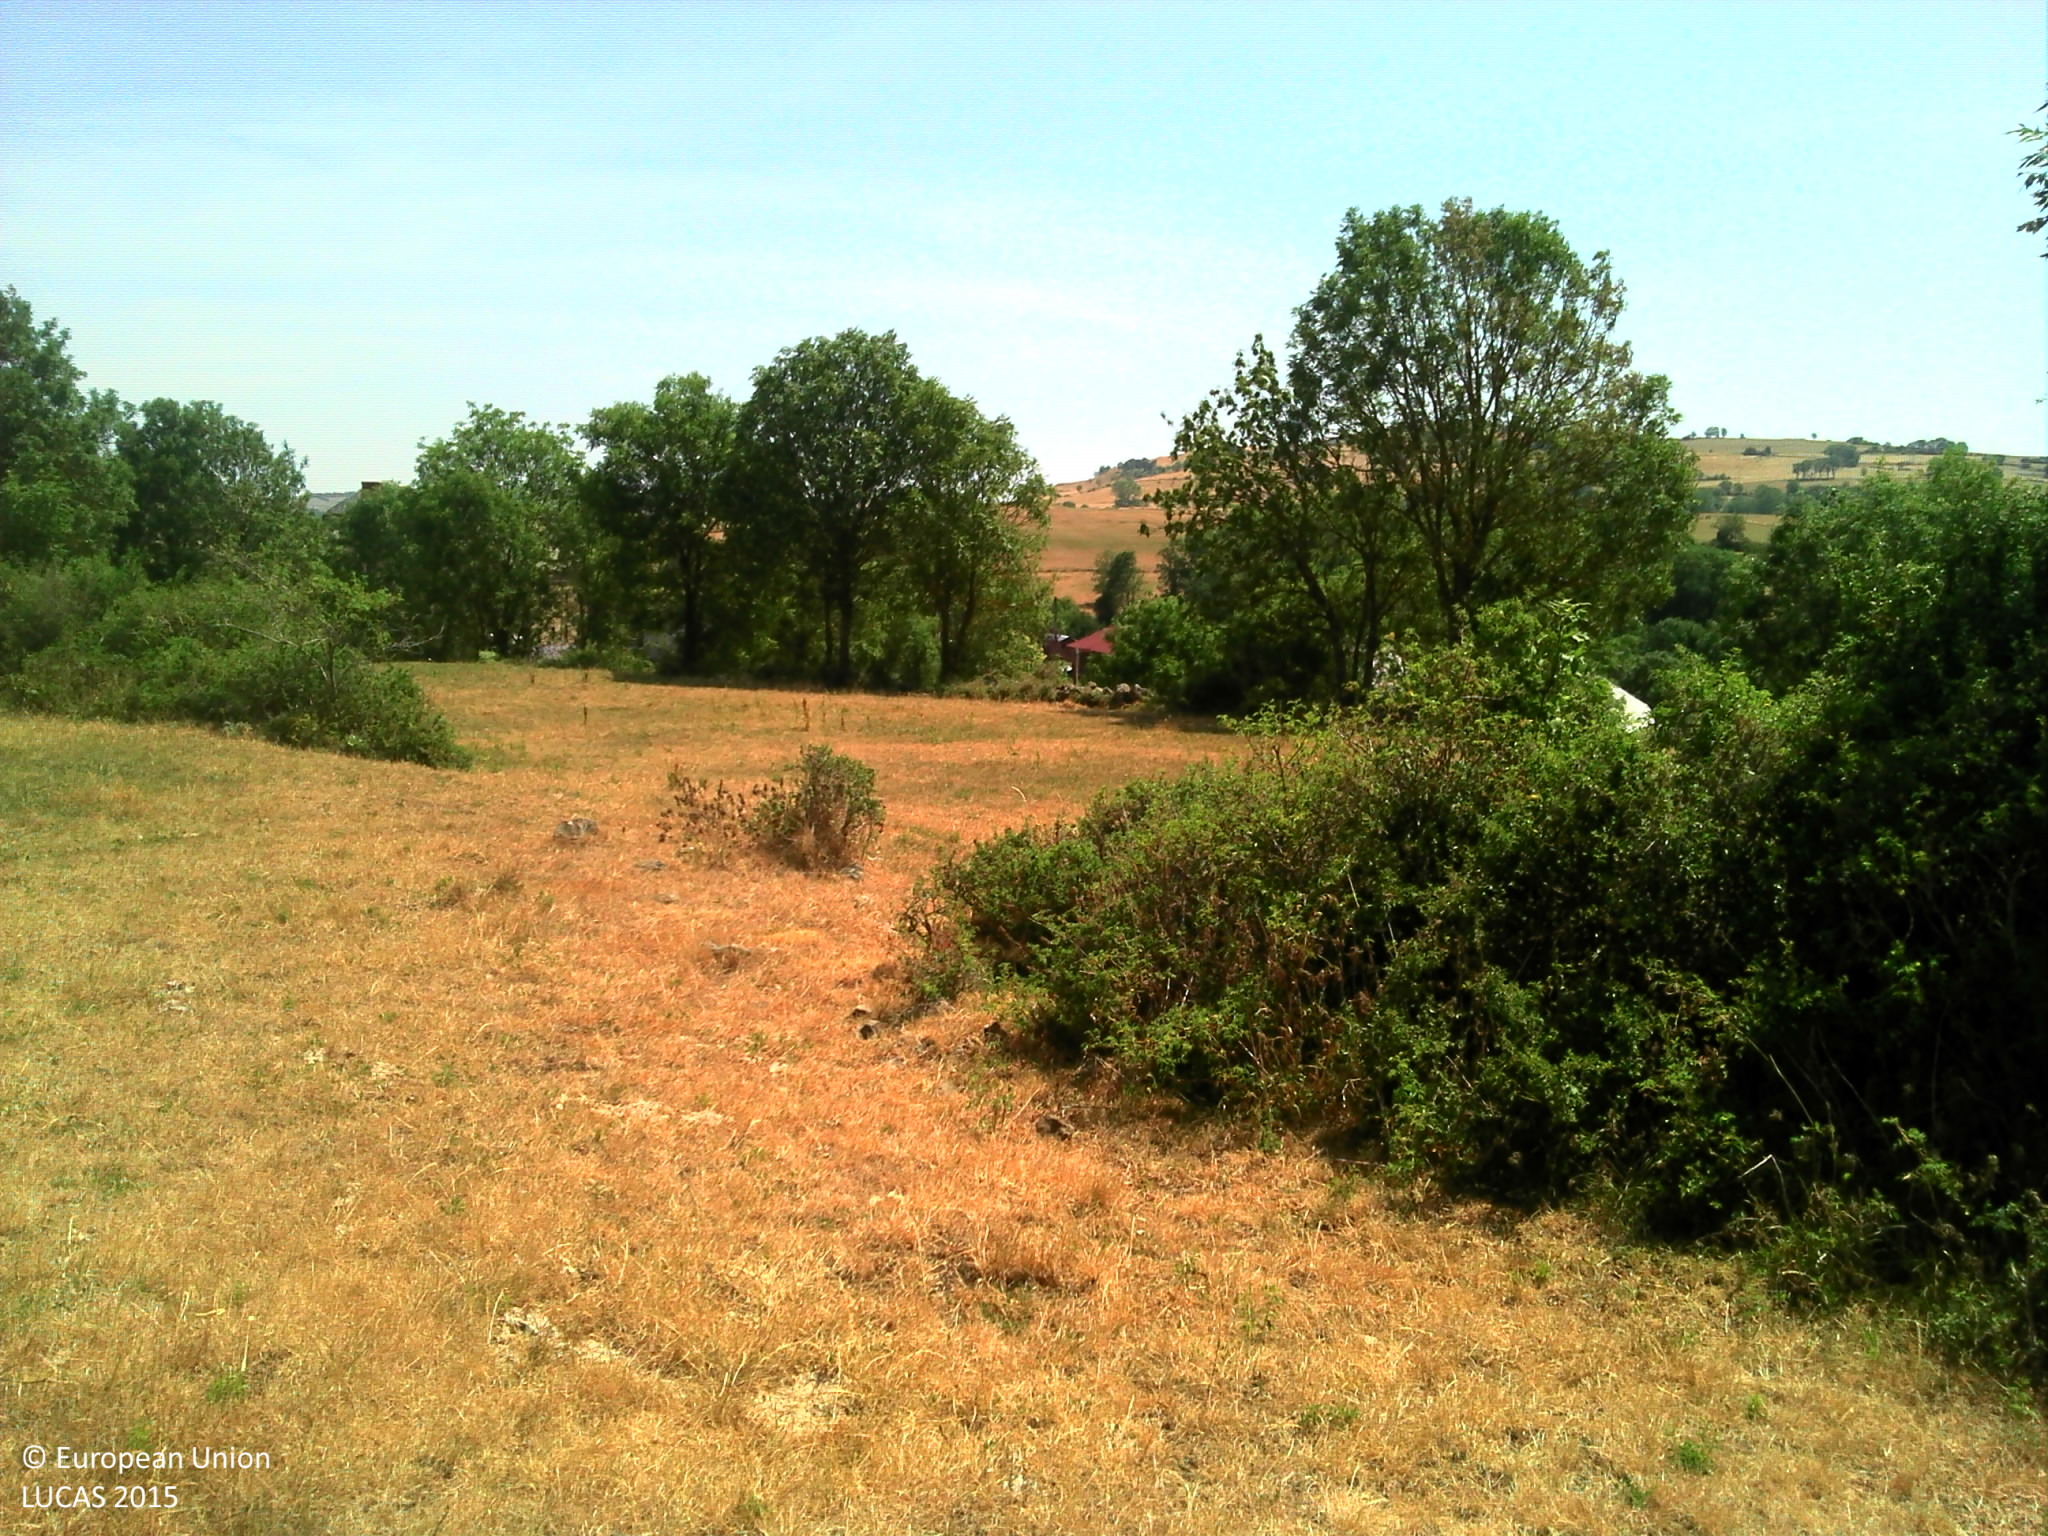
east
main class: Grassland
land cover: Grassland without tree/shrub cover
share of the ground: > 75 %
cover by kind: herbaceous plants 100 %
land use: Agriculture (excluding fallow land and kitchen gardens)
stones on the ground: < 10 %
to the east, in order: Grassland without tree/shrub cover; Abandoned hedges; Electric lines; Dry stone walls; Lines of trees; Grassland without tree/shrub cover; Dry stone walls; Lines of trees; Grassland without tree/shrub cover; Fences; Dry stone walls; Grassland without tree/shrub cover; Artificial constructions in urban areas
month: July
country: FR
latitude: 45.0928
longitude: 3.0261
